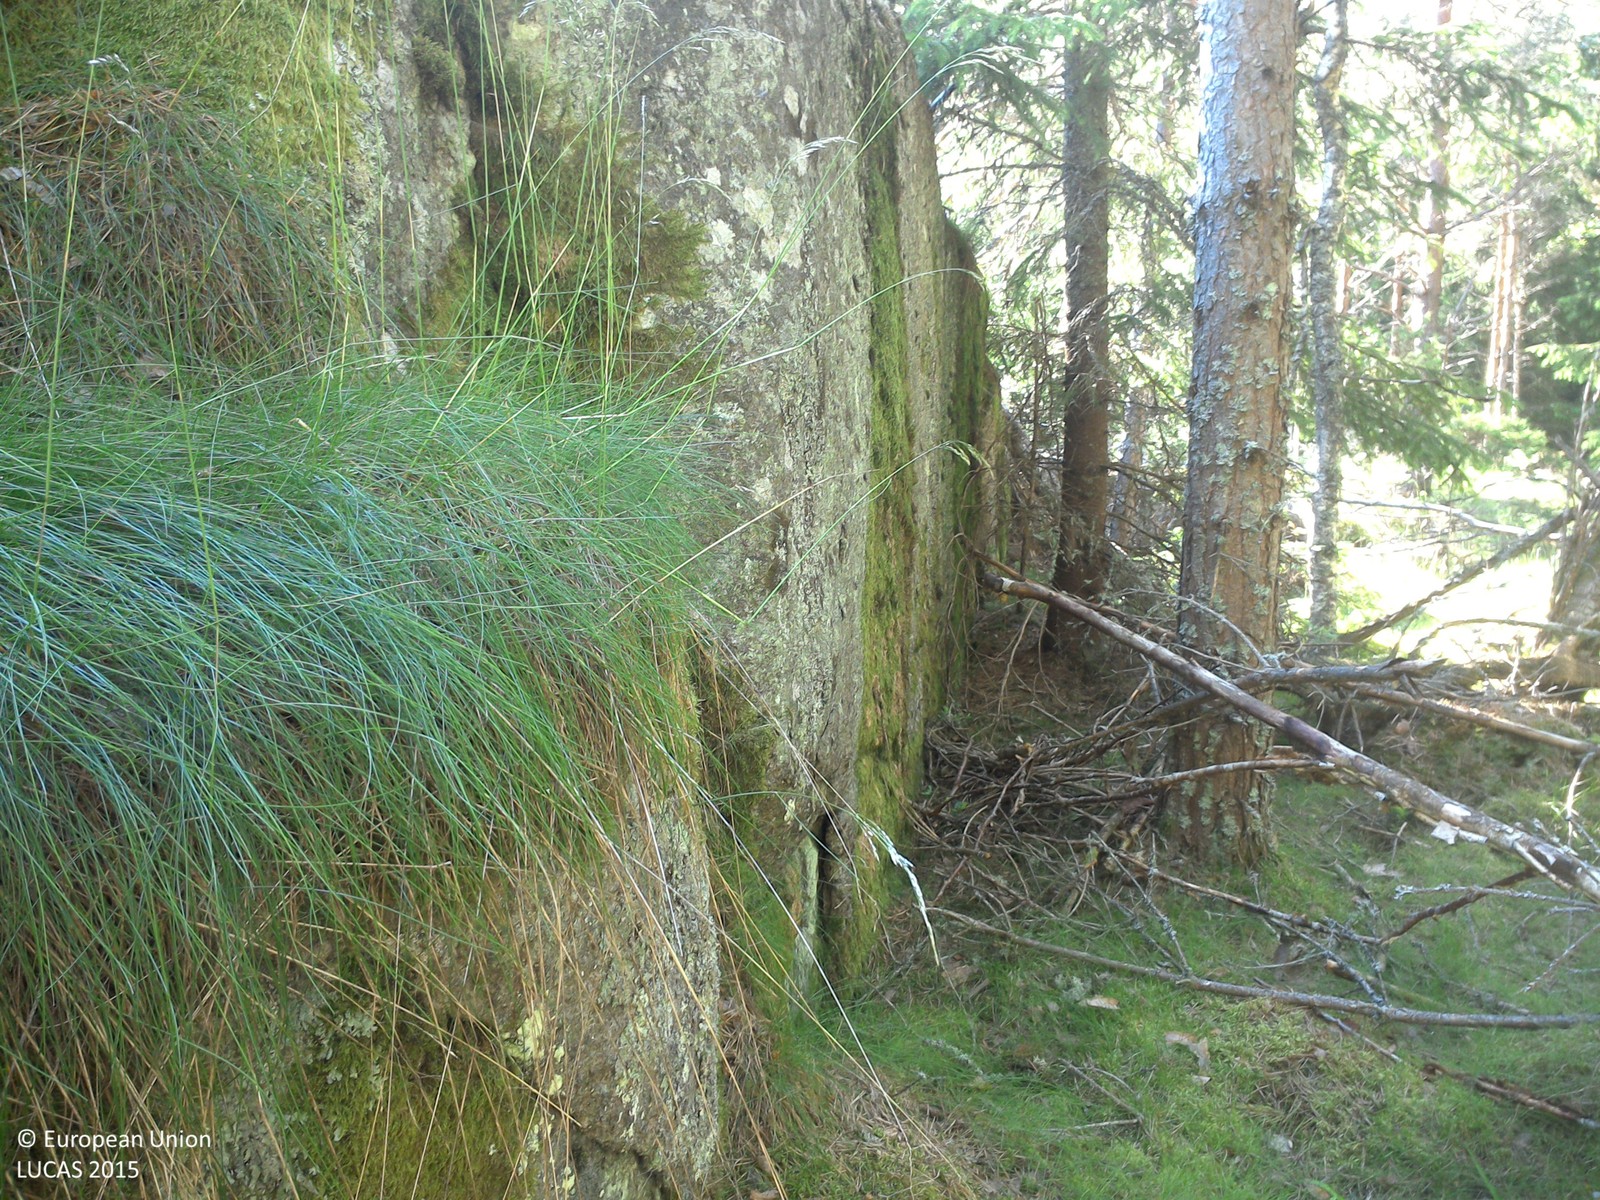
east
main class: Woodland
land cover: Spruce dominated coniferous woodland
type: boreal forest
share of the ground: 50 - 75 %
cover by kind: coniferous forest trees 65 %, lichens and mosses 20 %, herbaceous plants 15 %
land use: Forestry
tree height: > 5 m
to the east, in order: Spruce dominated coniferous woodland; Rocks and stones; Lichens and moss; Spruce dominated coniferous woodland; Rivers and streams; Pine dominated coniferous woodland
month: June
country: SE
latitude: 57.9906
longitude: 15.6962
